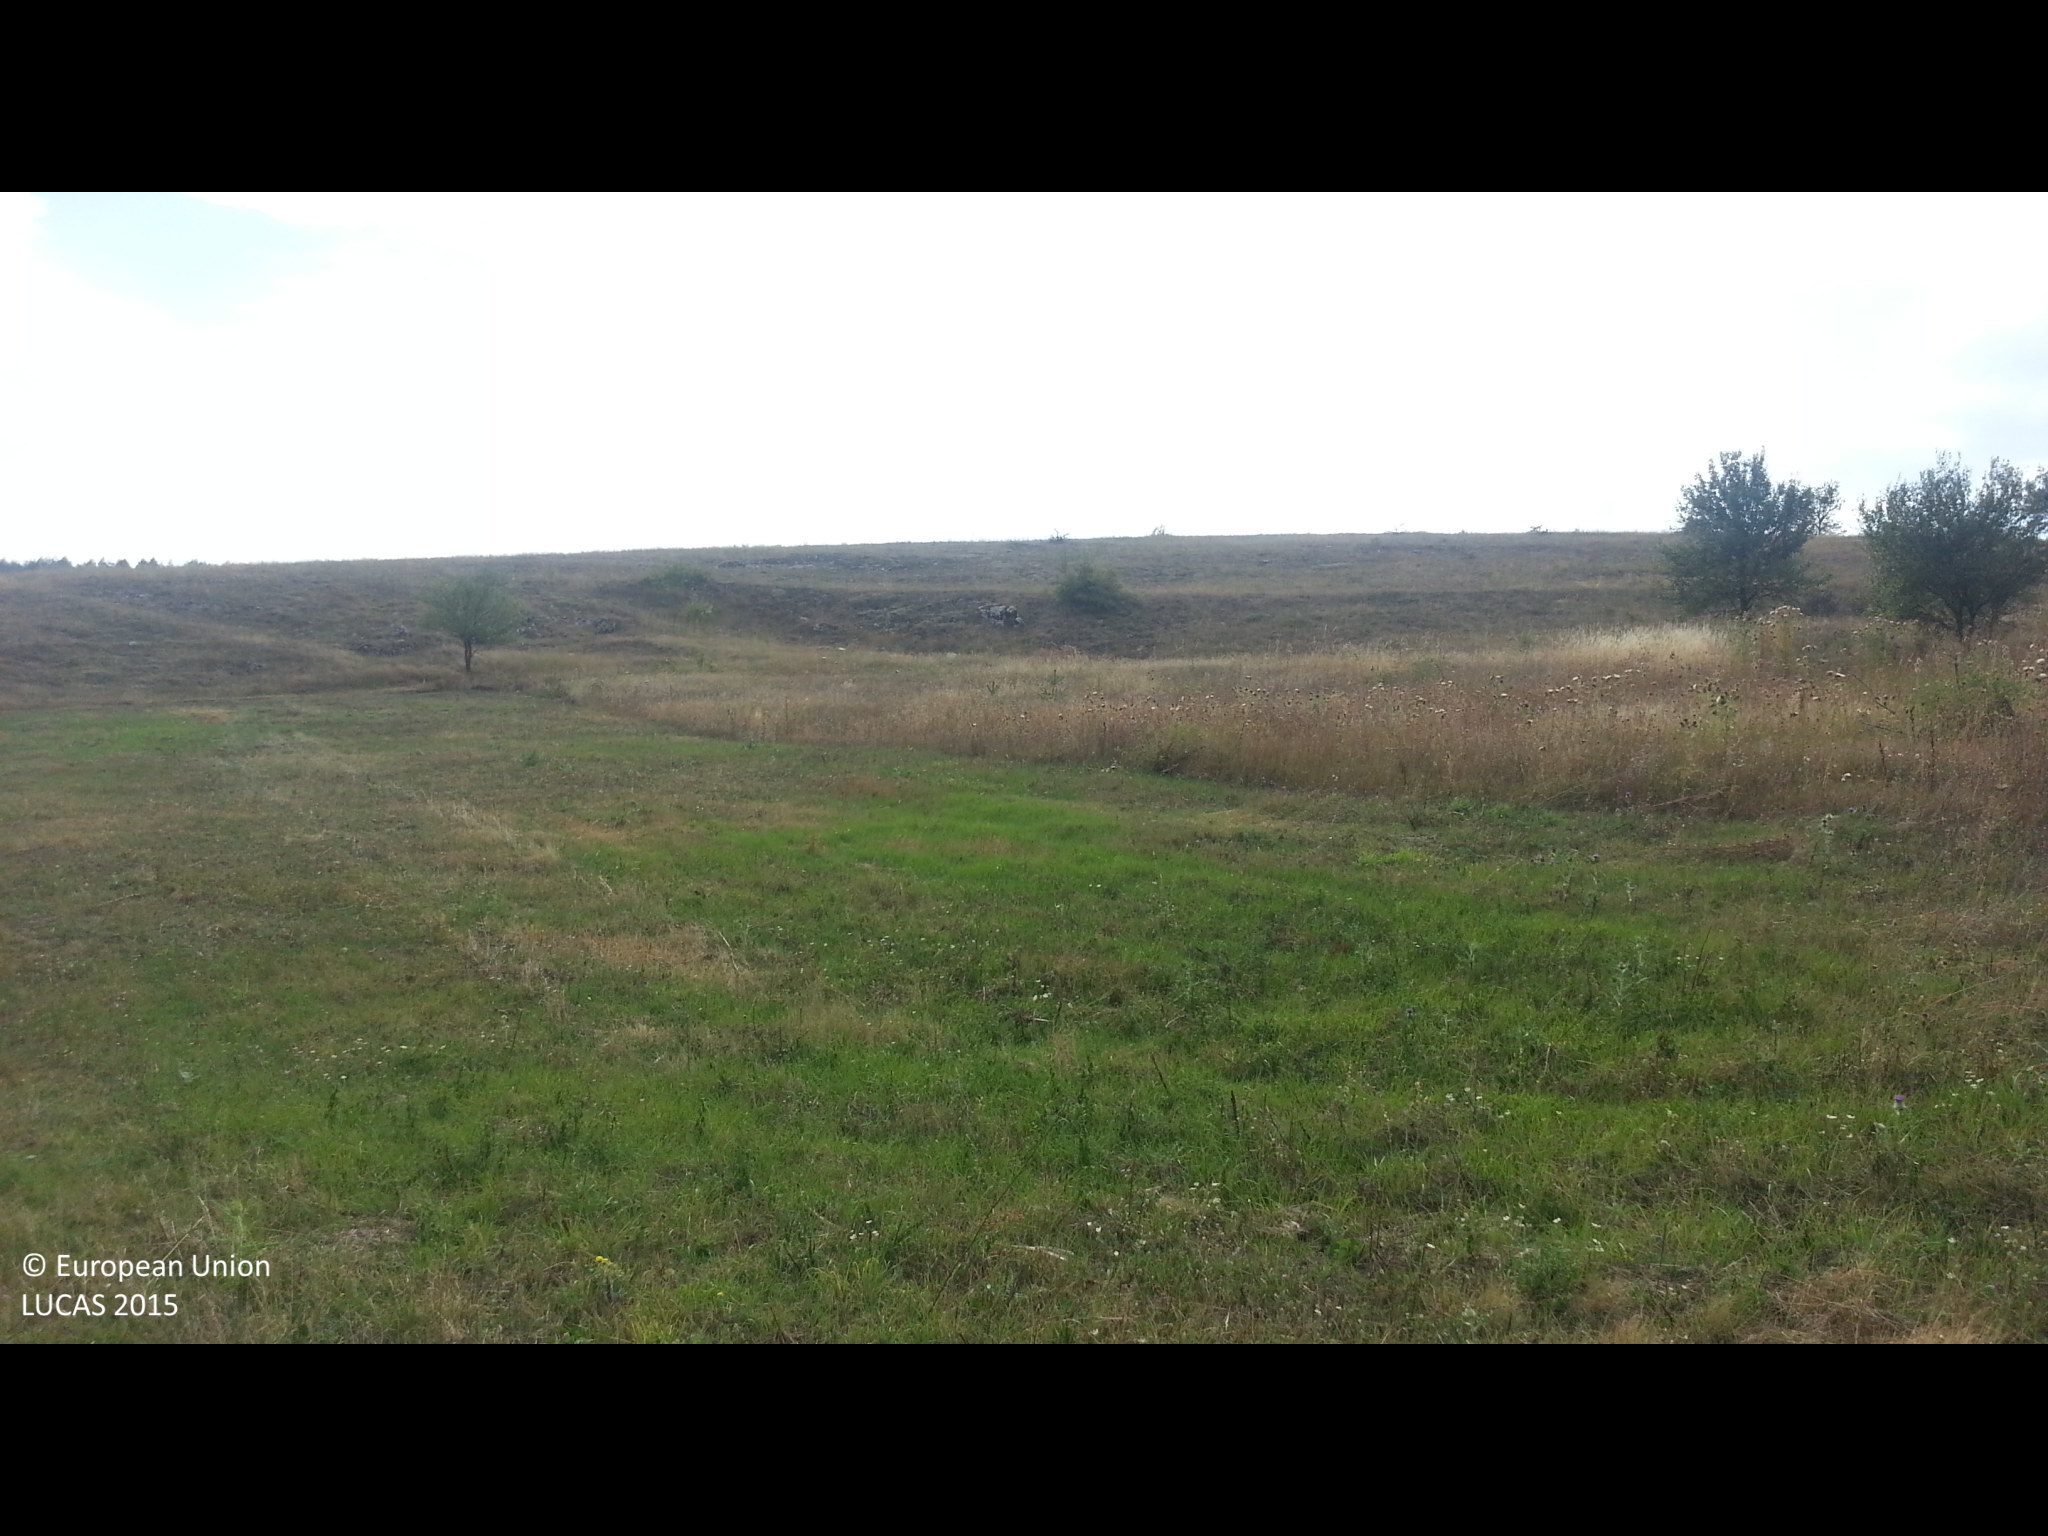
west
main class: Grassland
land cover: Grassland without tree/shrub cover
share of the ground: > 75 %
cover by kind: herbaceous plants 100 %
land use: Agriculture (excluding fallow land and kitchen gardens)
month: September
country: BG
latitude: 42.4649
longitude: 22.6099
